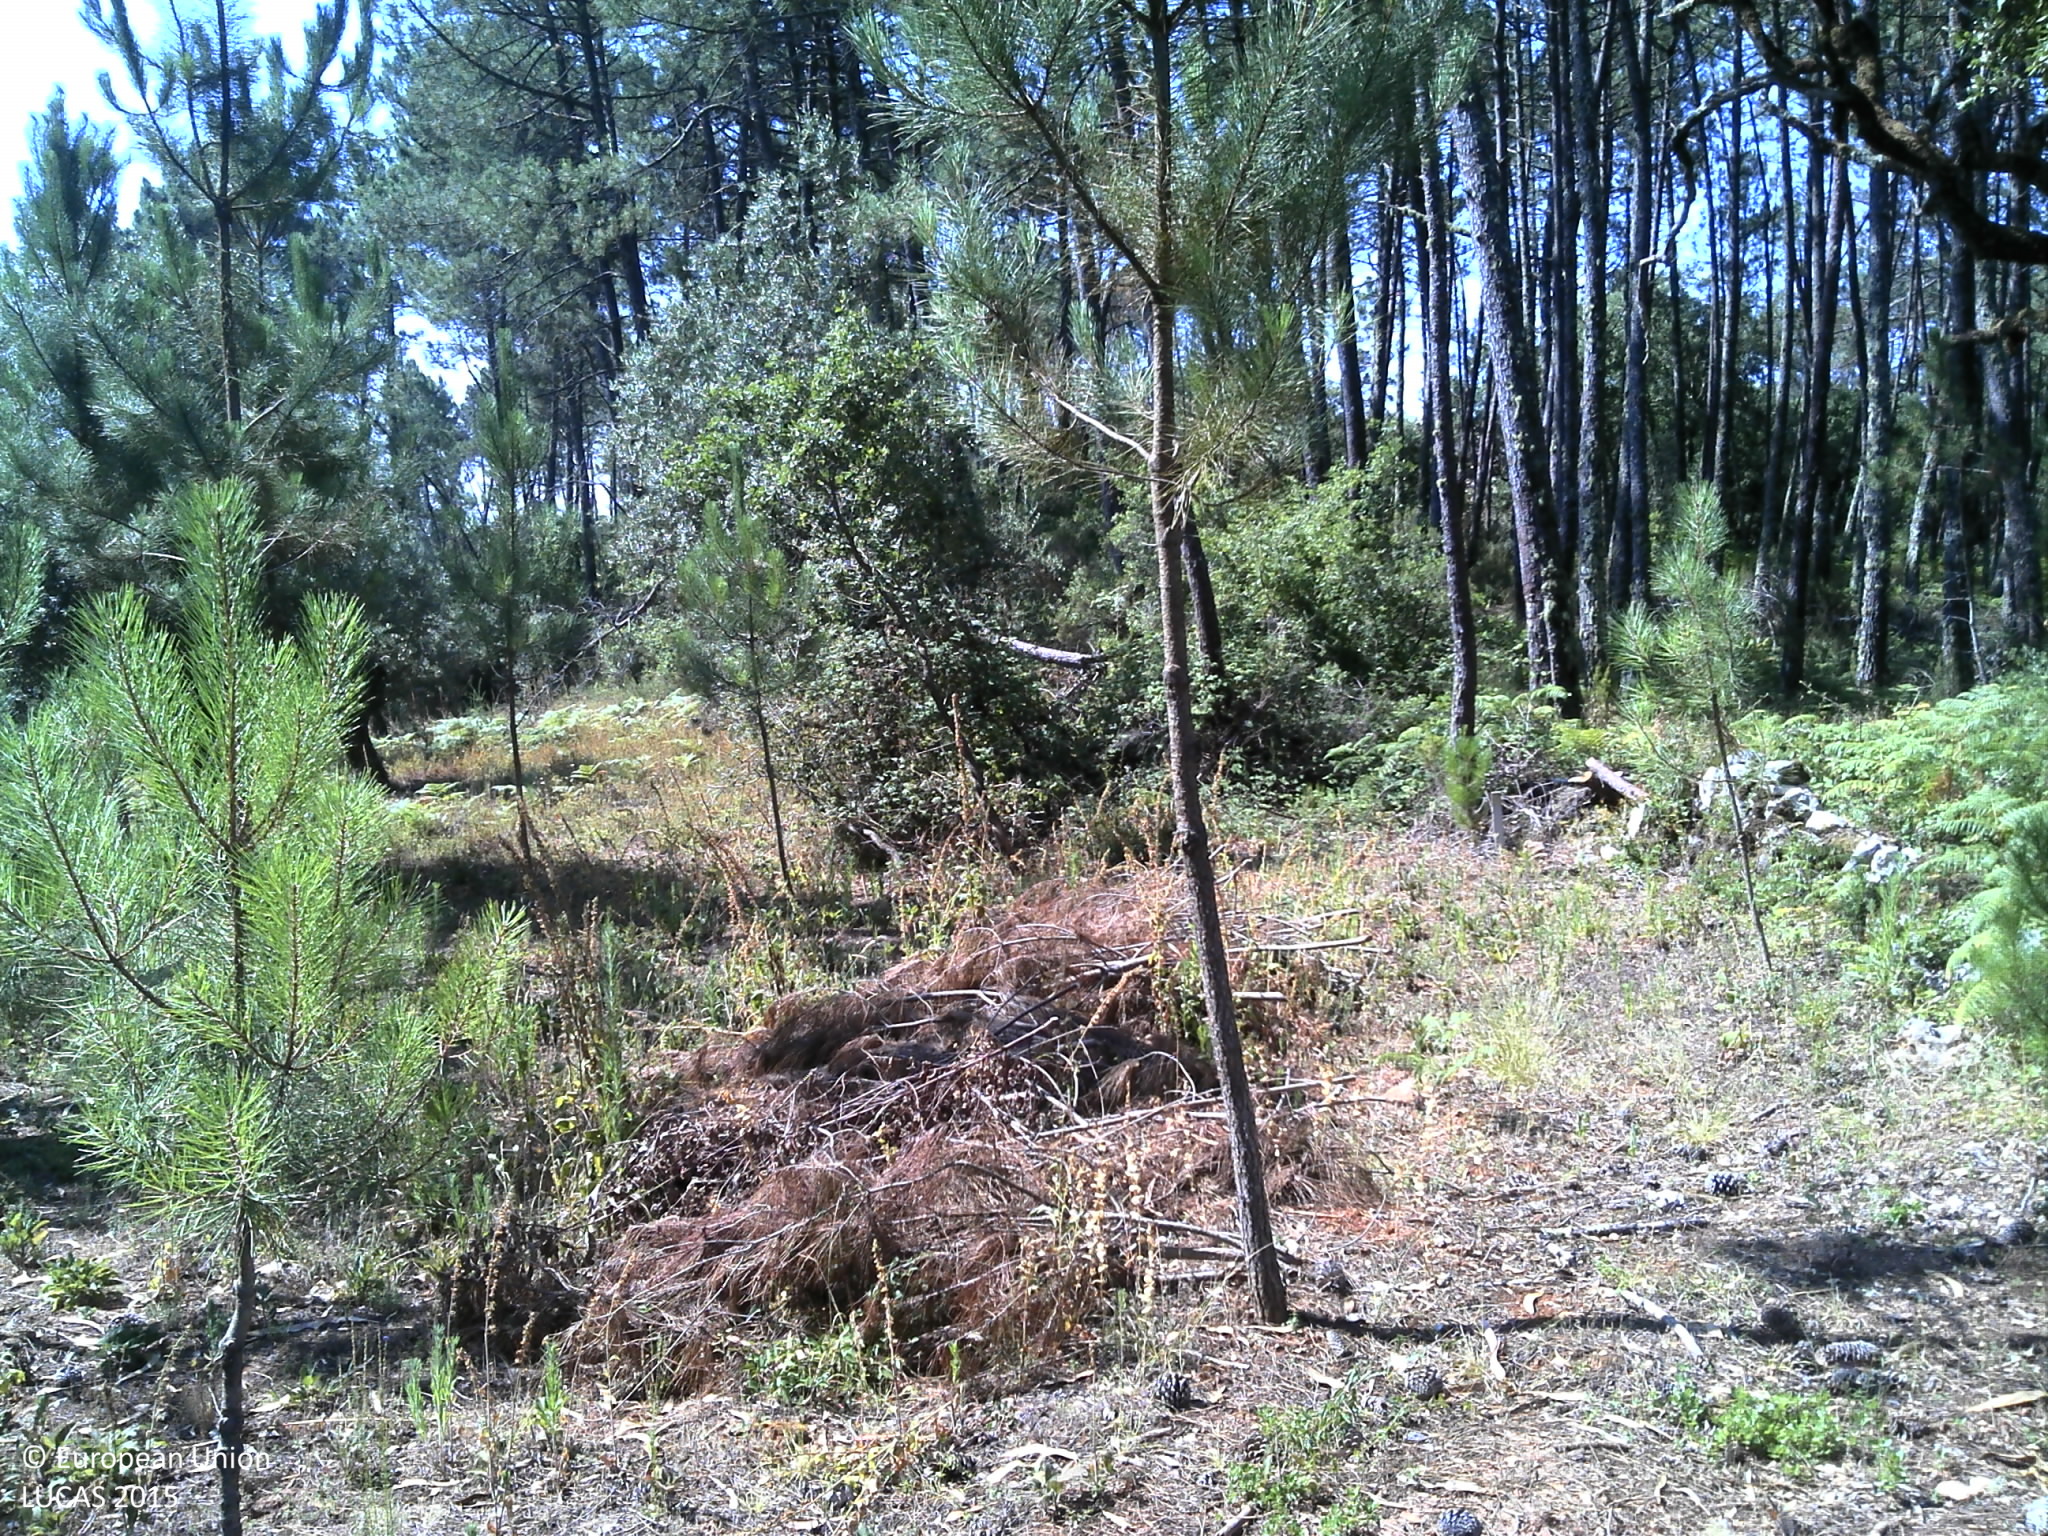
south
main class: Woodland
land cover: Broadleaved woodland
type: exotic forest
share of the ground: 50 - 75 %
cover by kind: broadleaved forest trees 55 %, unconsolidated bare surface 40 %, shrubs 5 %
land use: Forestry
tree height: > 5 m
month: July
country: PT
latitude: 39.9403
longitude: -8.4653
